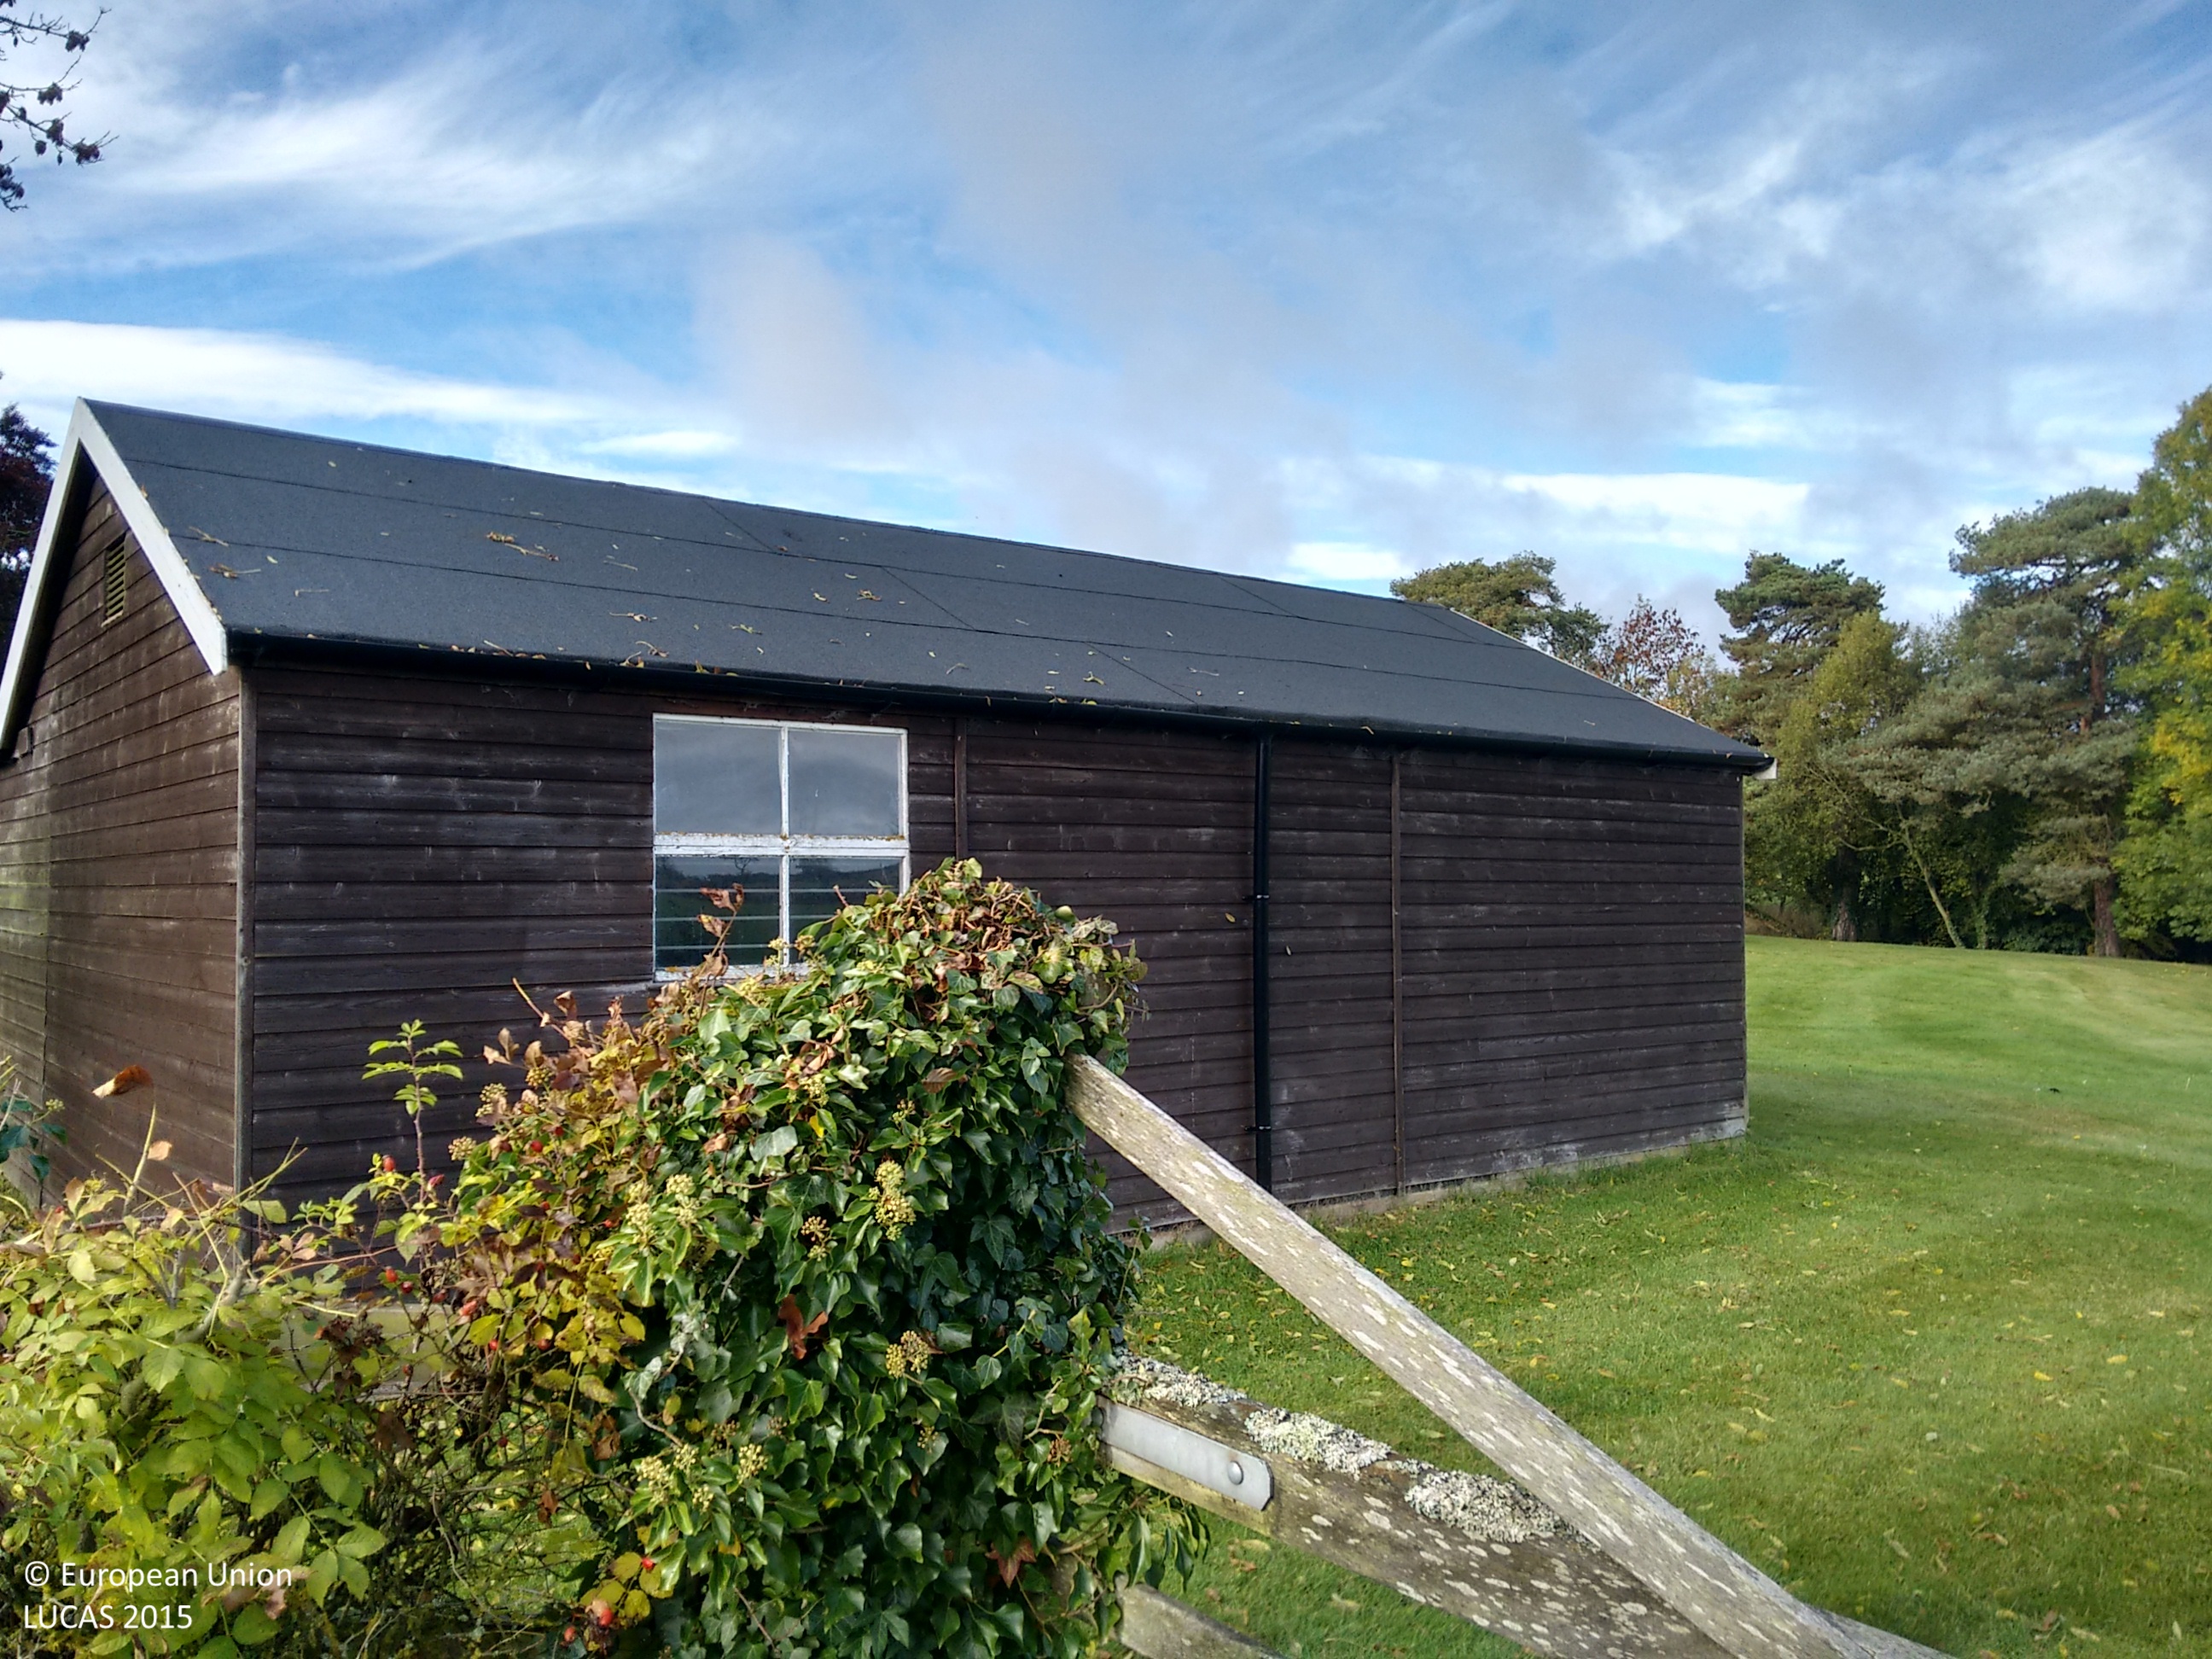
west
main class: Grassland
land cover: Grassland without tree/shrub cover
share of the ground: > 75 %
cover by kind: herbaceous plants 100 %
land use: Agriculture (excluding fallow land and kitchen gardens)
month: October
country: GB
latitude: 52.0505
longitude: -1.7053
